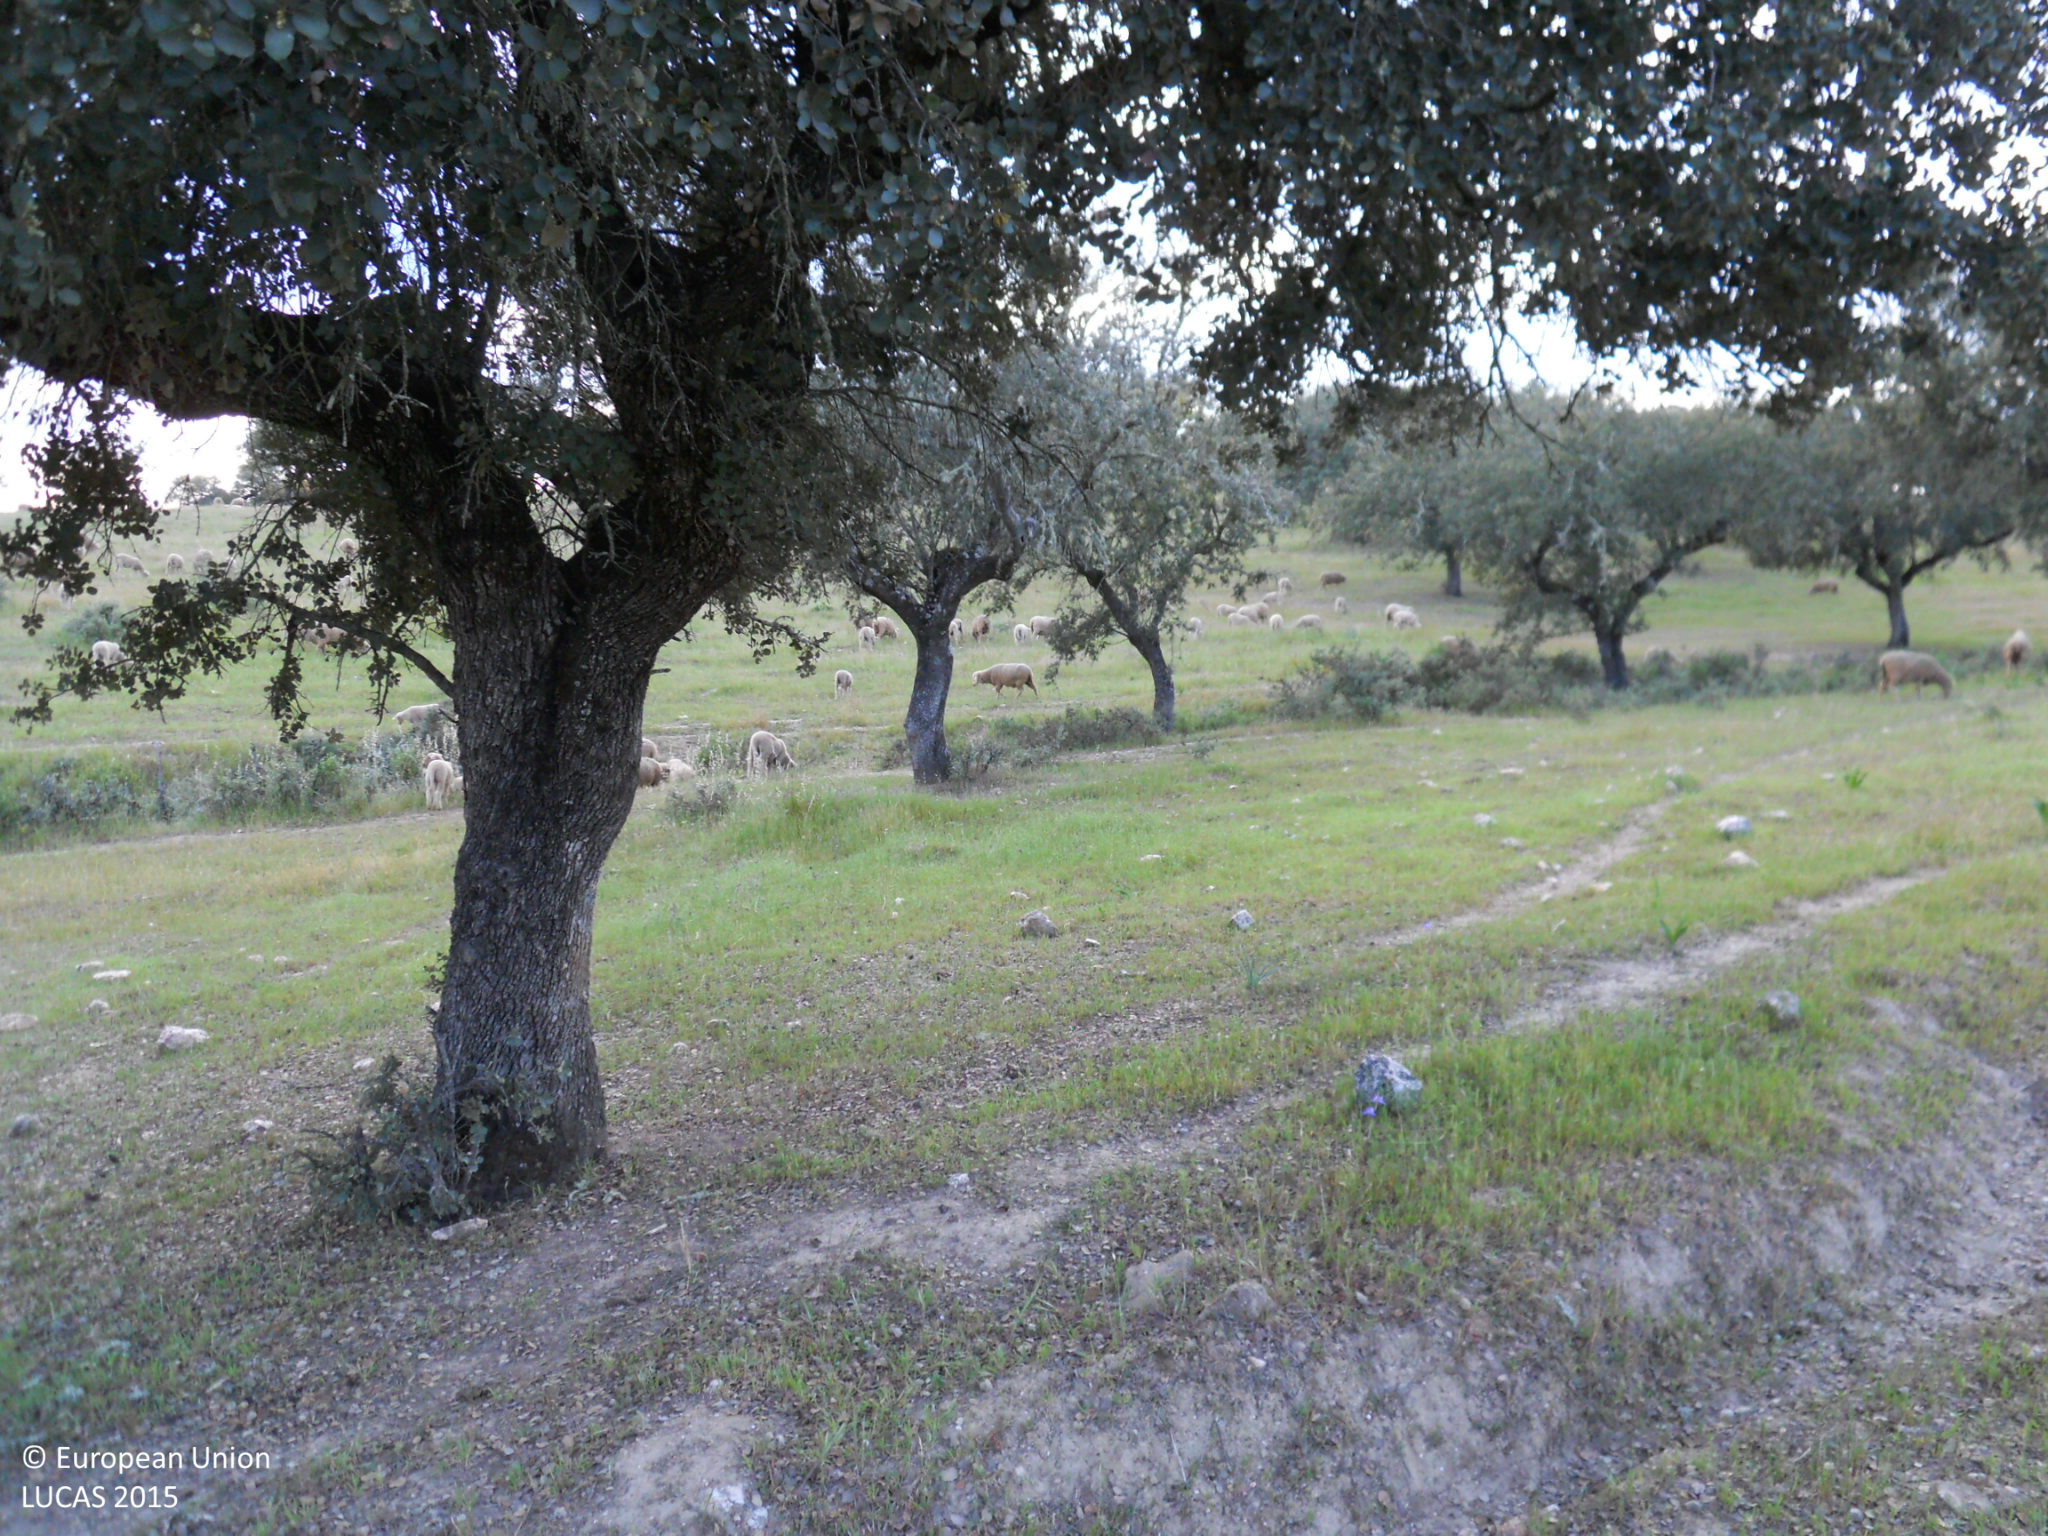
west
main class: Woodland
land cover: Broadleaved woodland
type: broadleaved evergreen forest
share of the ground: > 75 %
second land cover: Grassland without tree/shrub cover
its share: > 75 %
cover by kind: broadleaved forest trees 95 %, herbaceous plants 5 %
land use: Forestry
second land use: Agriculture (excluding fallow land and kitchen gardens)
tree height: > 5 m
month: April
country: ES
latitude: 39.2329
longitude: -6.7892
